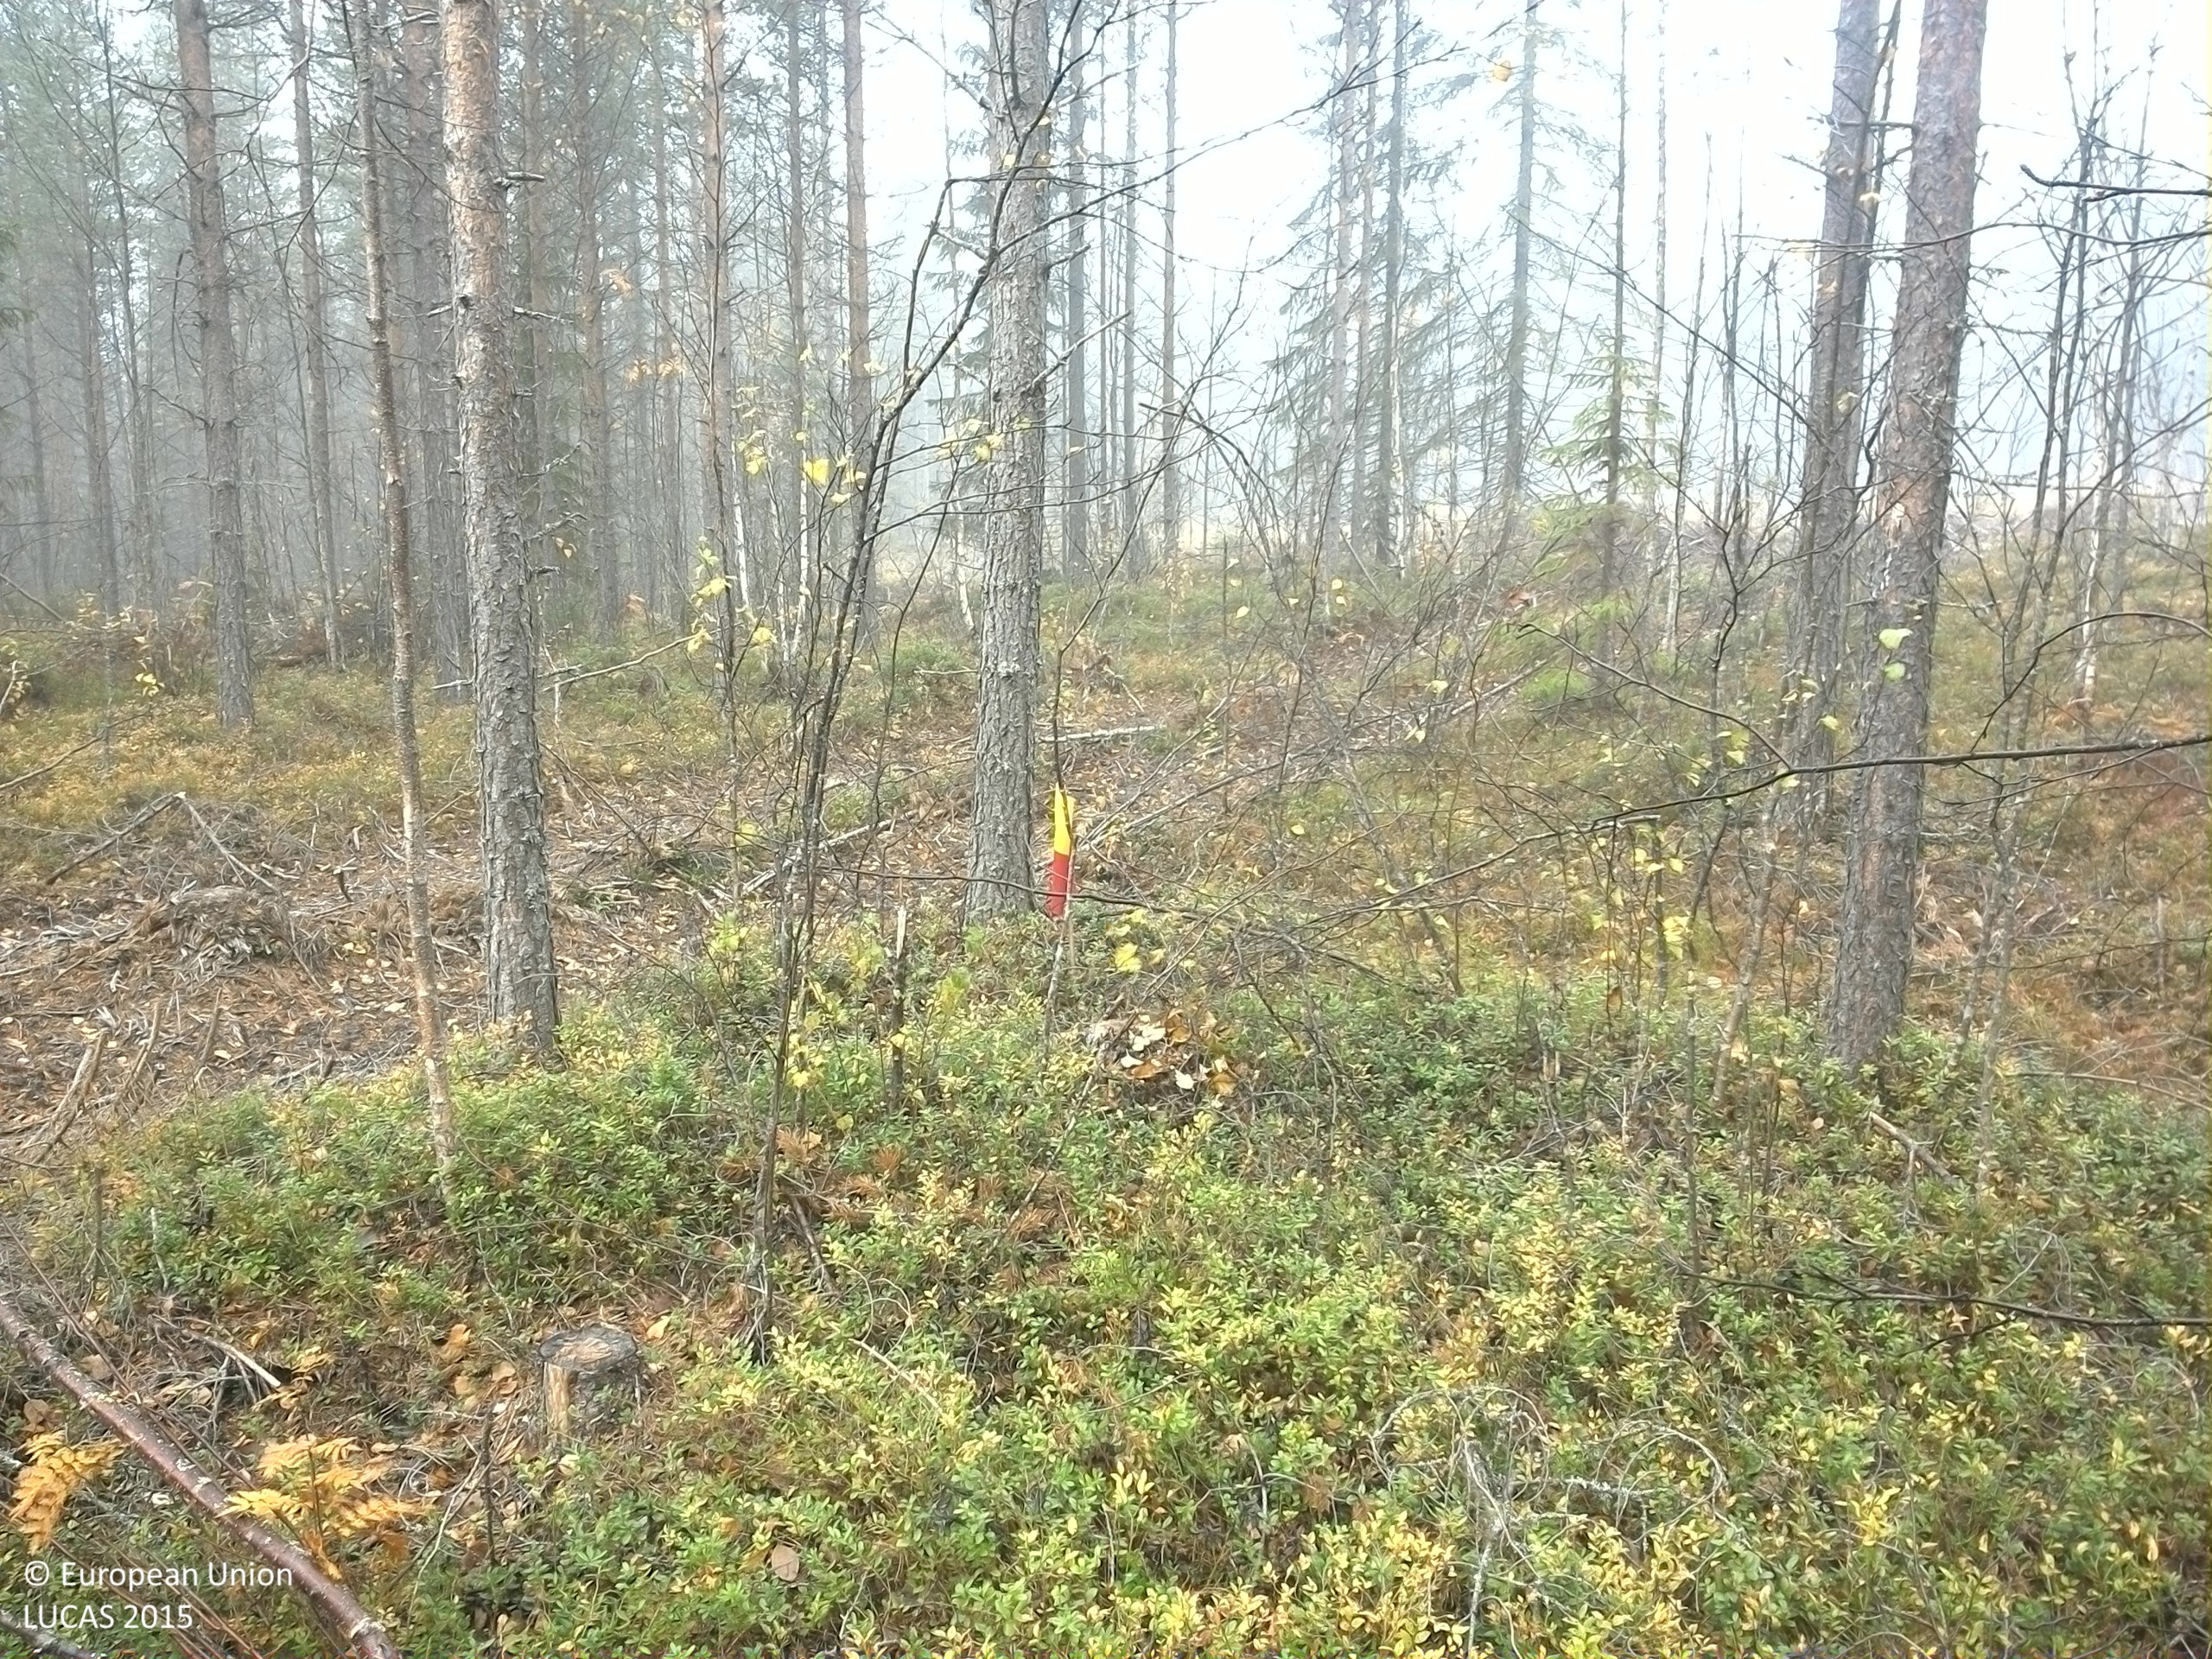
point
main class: Woodland
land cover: Pine dominated mixed woodland
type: boreal forest
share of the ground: 50 - 75 %
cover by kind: coniferous forest trees 45 %, shrubs 30 %, broadleaved forest trees 15 %, lichens and mosses 10 %
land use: Forestry
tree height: > 5 m
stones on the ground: 10 - 25 %
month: October
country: SE
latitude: 64.0017
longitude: 16.2893
